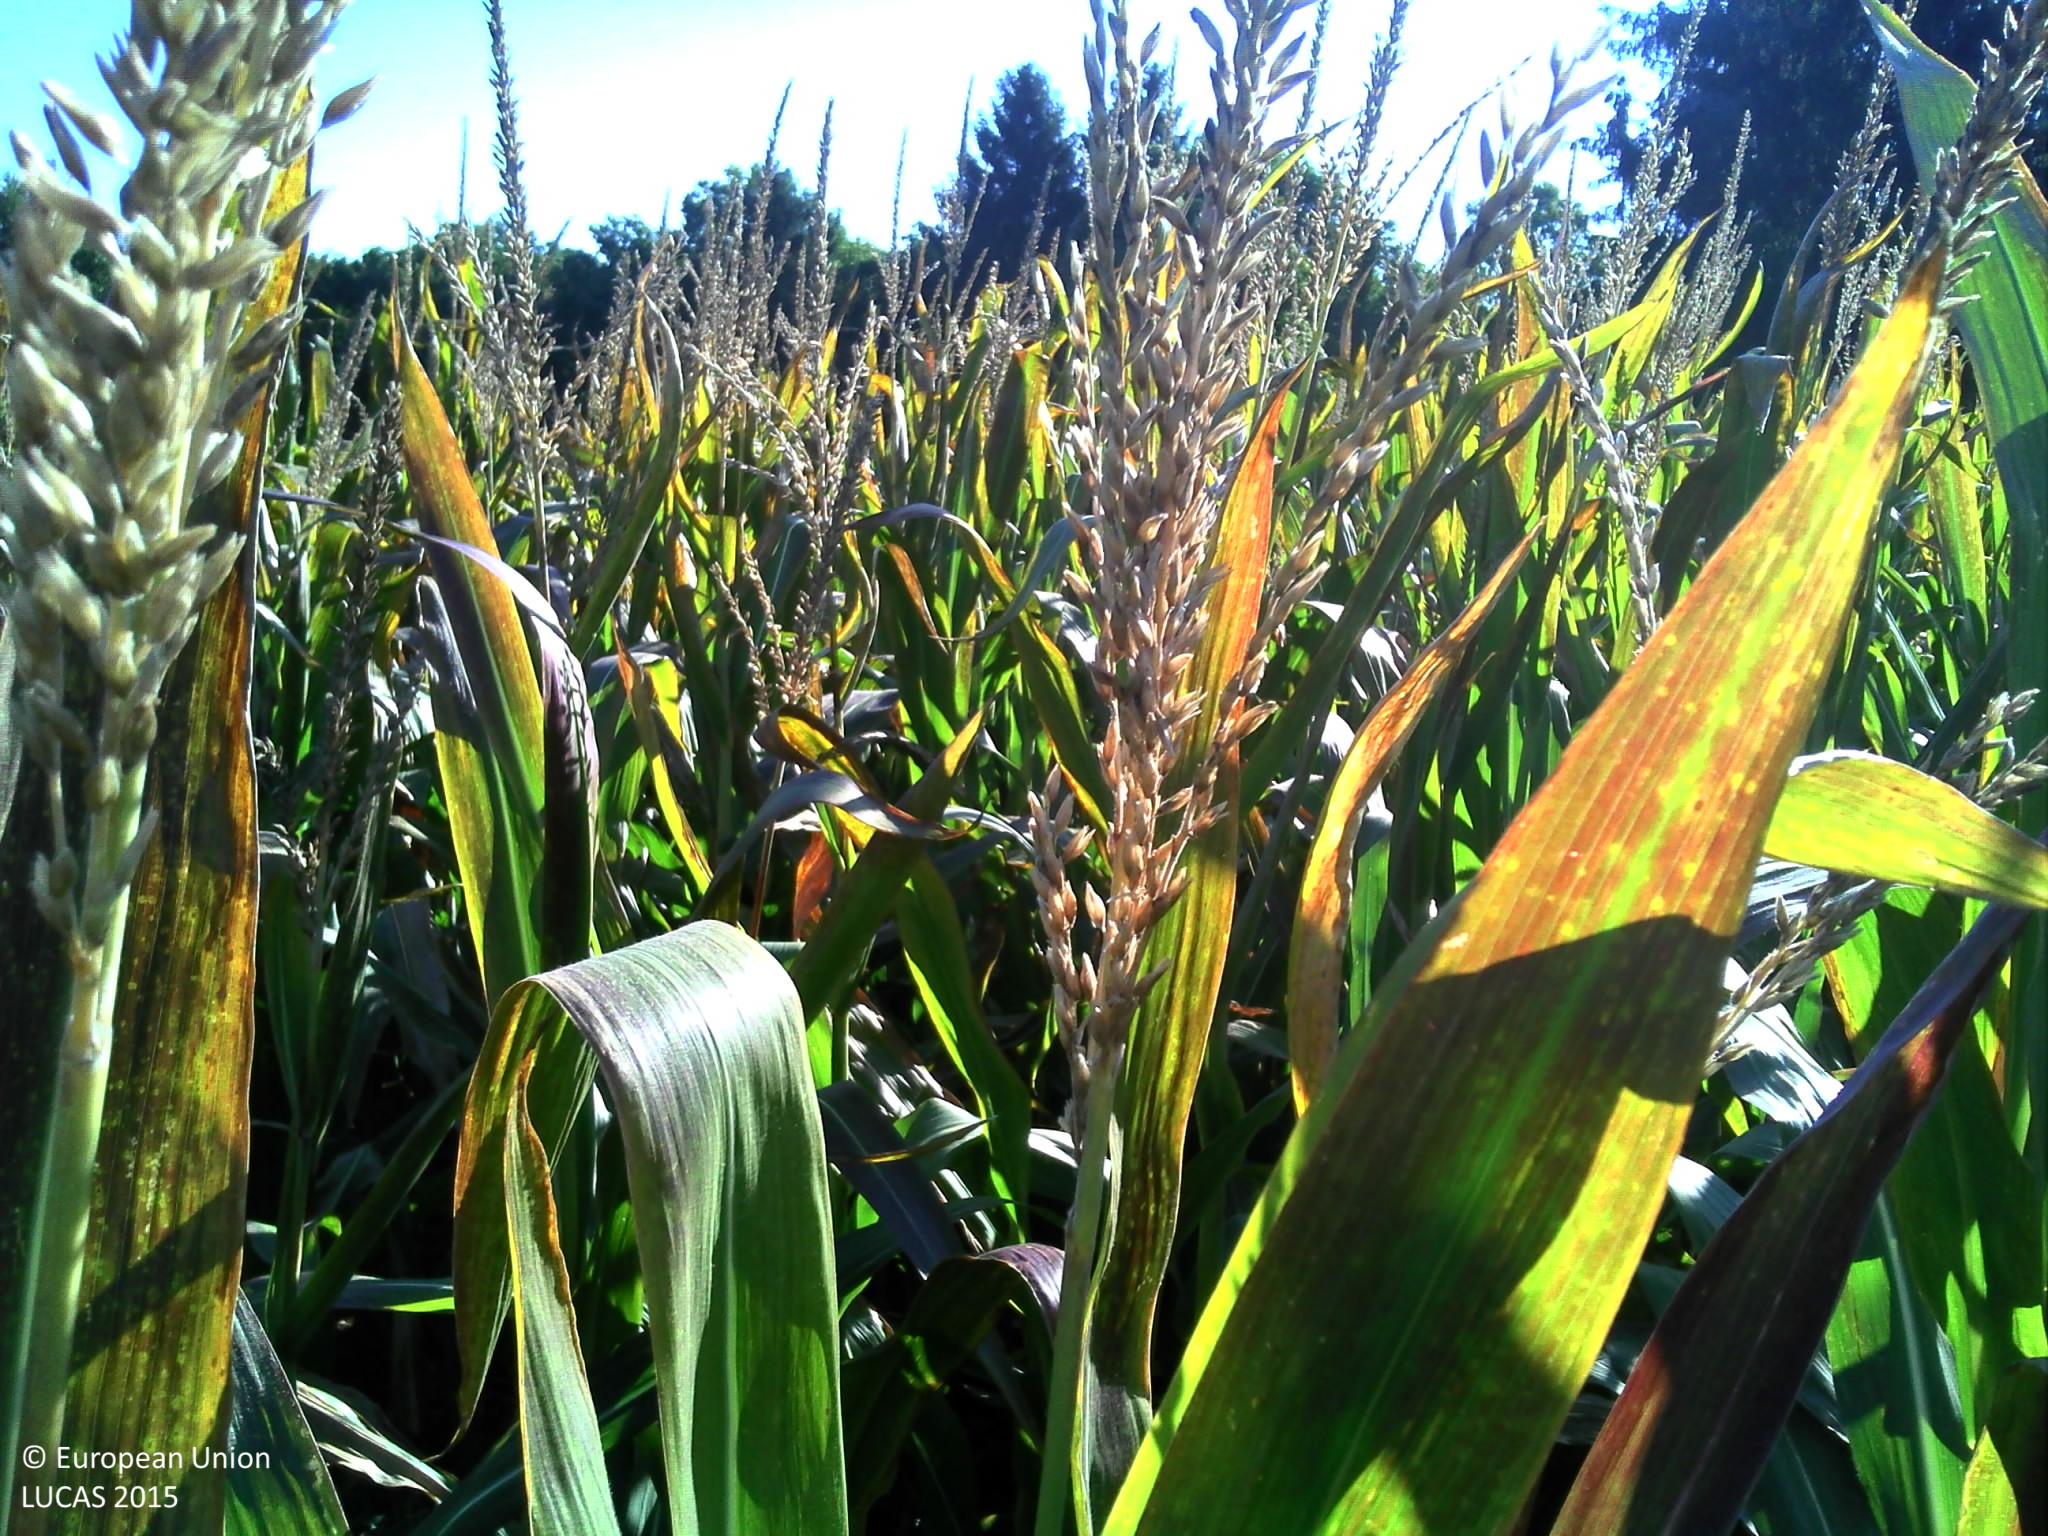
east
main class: Cropland
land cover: Maize
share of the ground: > 75 %
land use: Agriculture (excluding fallow land and kitchen gardens)
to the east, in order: Maize; Spontaneously vegetated surfaces; Shrubland without tree cover; Spruce dominated coniferous woodland; Grass margins; Fences; Grassland without tree/shrub cover; Fences; Grass margins; Rivers and streams; Broadleaved woodland; Rocks and stones; Tracks; Rocks and stones; Broadleaved woodland; Grass margins; Broadleaved woodland; Tracks; Broadleaved woodland; Tracks; Broadleaved woodland
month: September
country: FR
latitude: 49.3008
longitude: 5.9149
